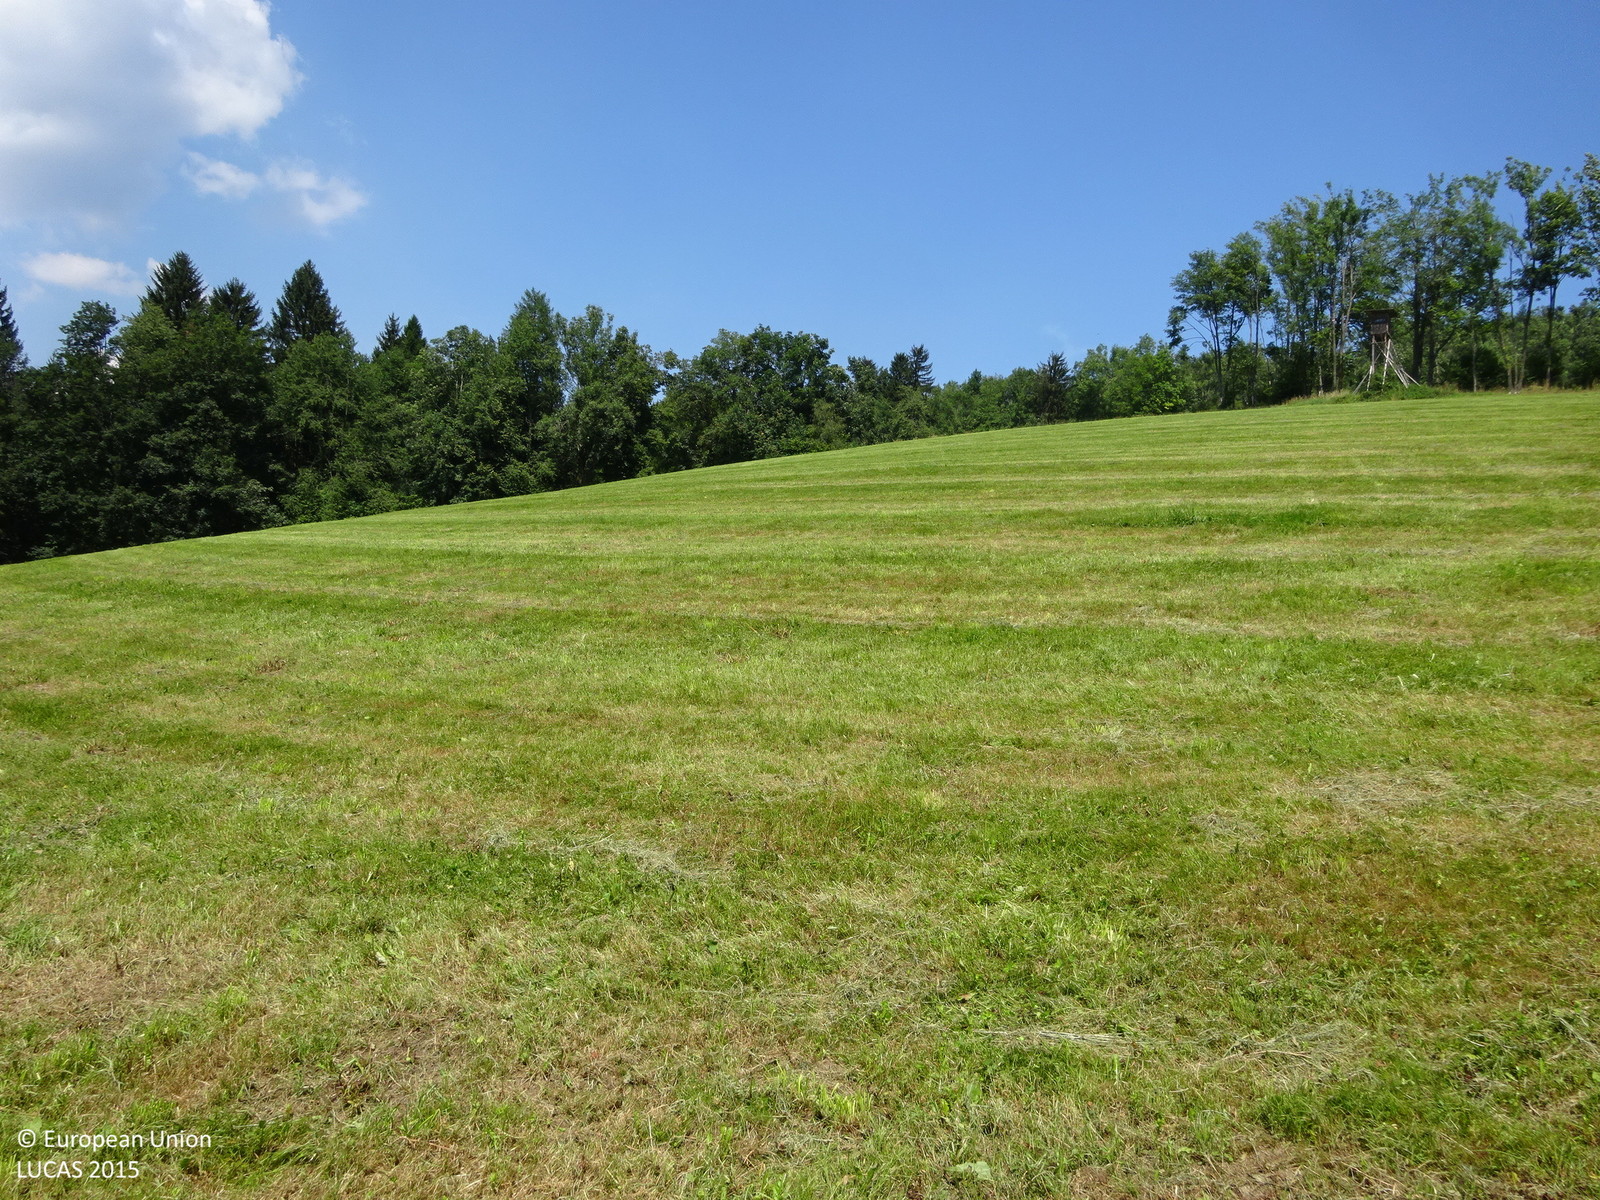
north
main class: Grassland
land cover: Grassland without tree/shrub cover
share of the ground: > 75 %
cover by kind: herbaceous plants 100 %
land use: Agriculture (excluding fallow land and kitchen gardens)
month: August
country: AT
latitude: 47.4969
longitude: 16.0688
